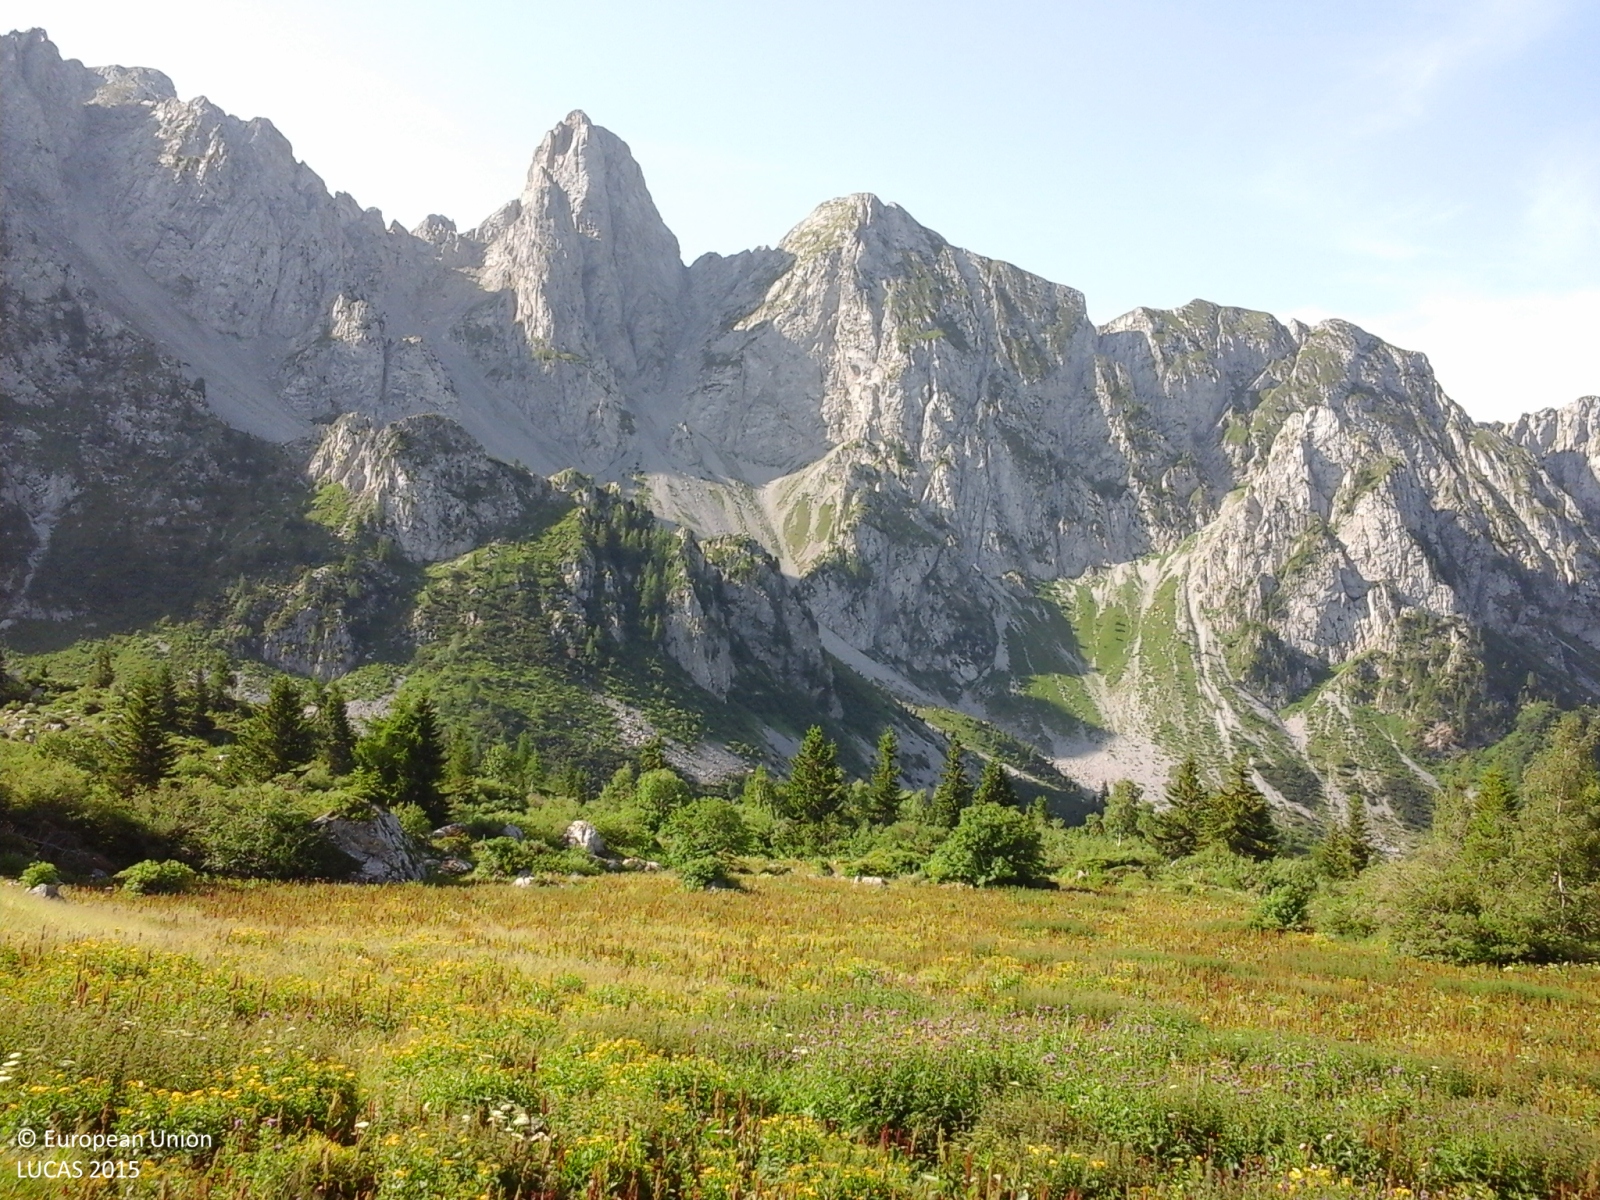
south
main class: Grassland
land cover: Grassland without tree/shrub cover
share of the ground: > 75 %
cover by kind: herbaceous plants 100 %
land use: Agriculture (excluding fallow land and kitchen gardens)
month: July
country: IT
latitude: 46.0267
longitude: 10.2451
